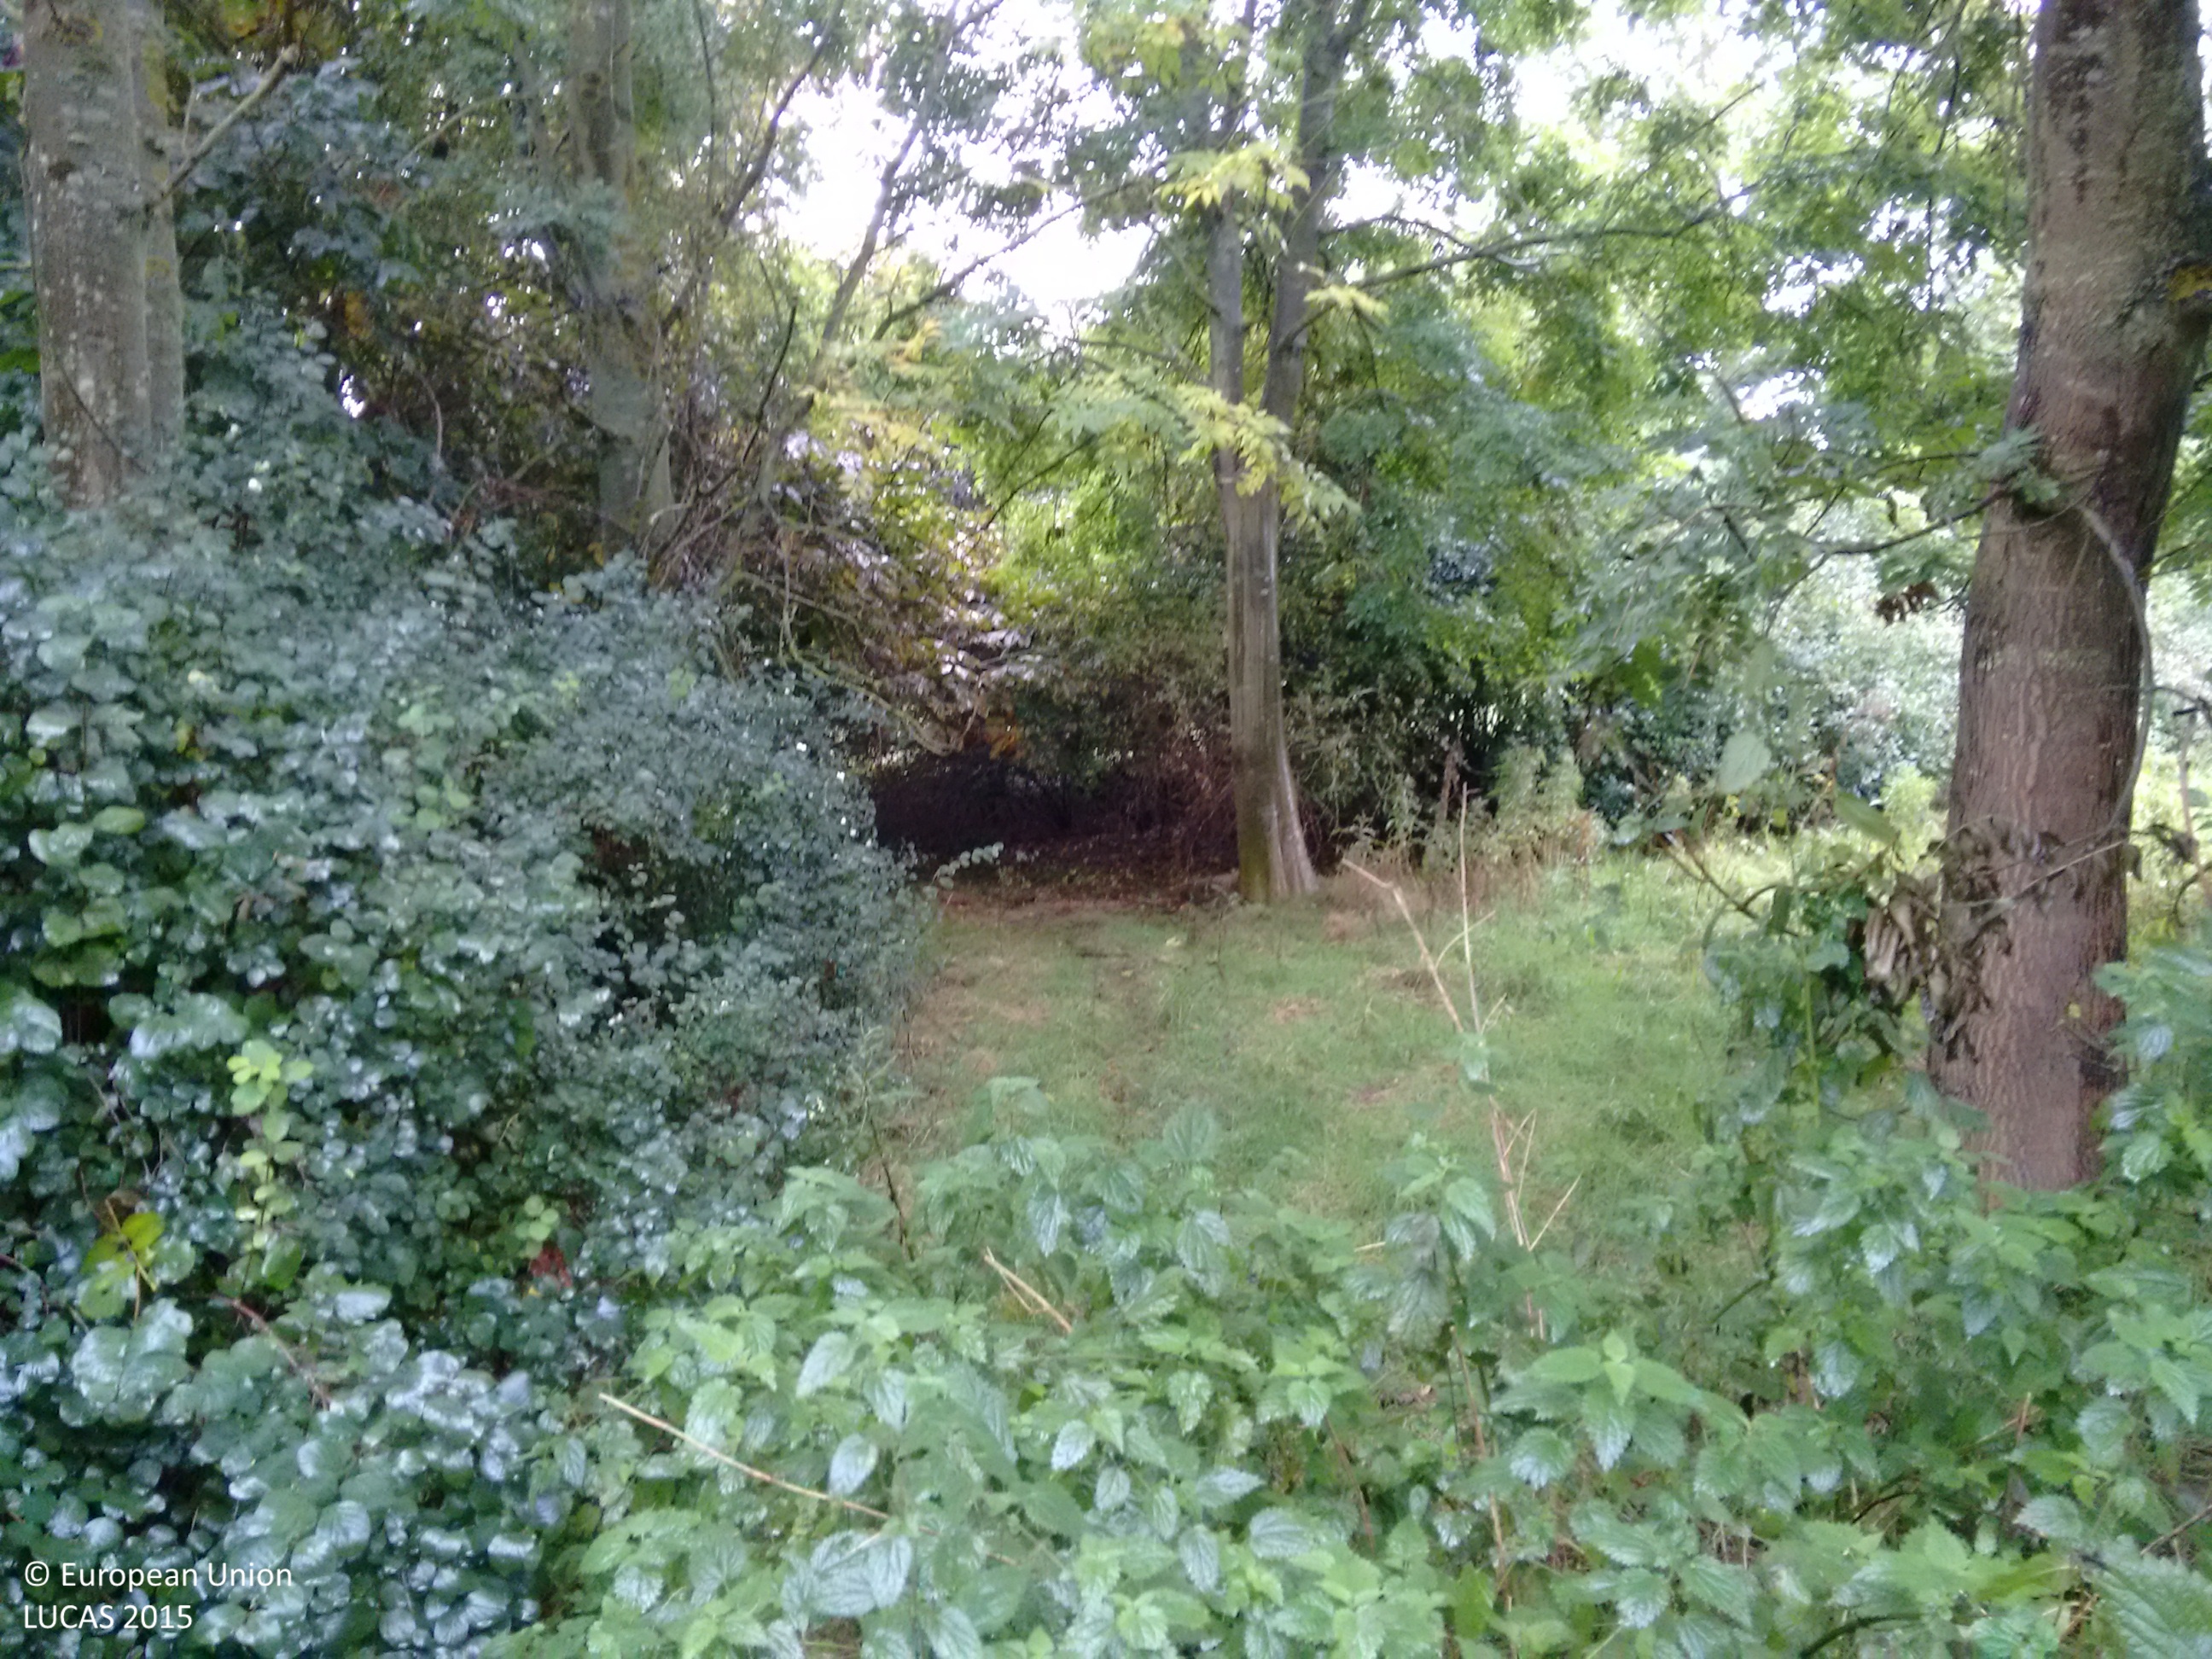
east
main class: Woodland
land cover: Broadleaved woodland
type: mesophytic deciduous forest
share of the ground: > 75 %
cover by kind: broadleaved forest trees 100 %
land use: Amenities, museums, leisure
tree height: > 5 m
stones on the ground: < 10 %
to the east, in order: Broadleaved woodland; Fences; Grassland without tree/shrub cover; Single bushes/trees; Artificial constructions in urban areas; Grassland with sparse tree/shrub cover; Fences; Paved roads, cycling and walking lanes; Grass margins; Shrubland with sparse tree cover
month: October
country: GB
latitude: 52.5055
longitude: 1.7472
